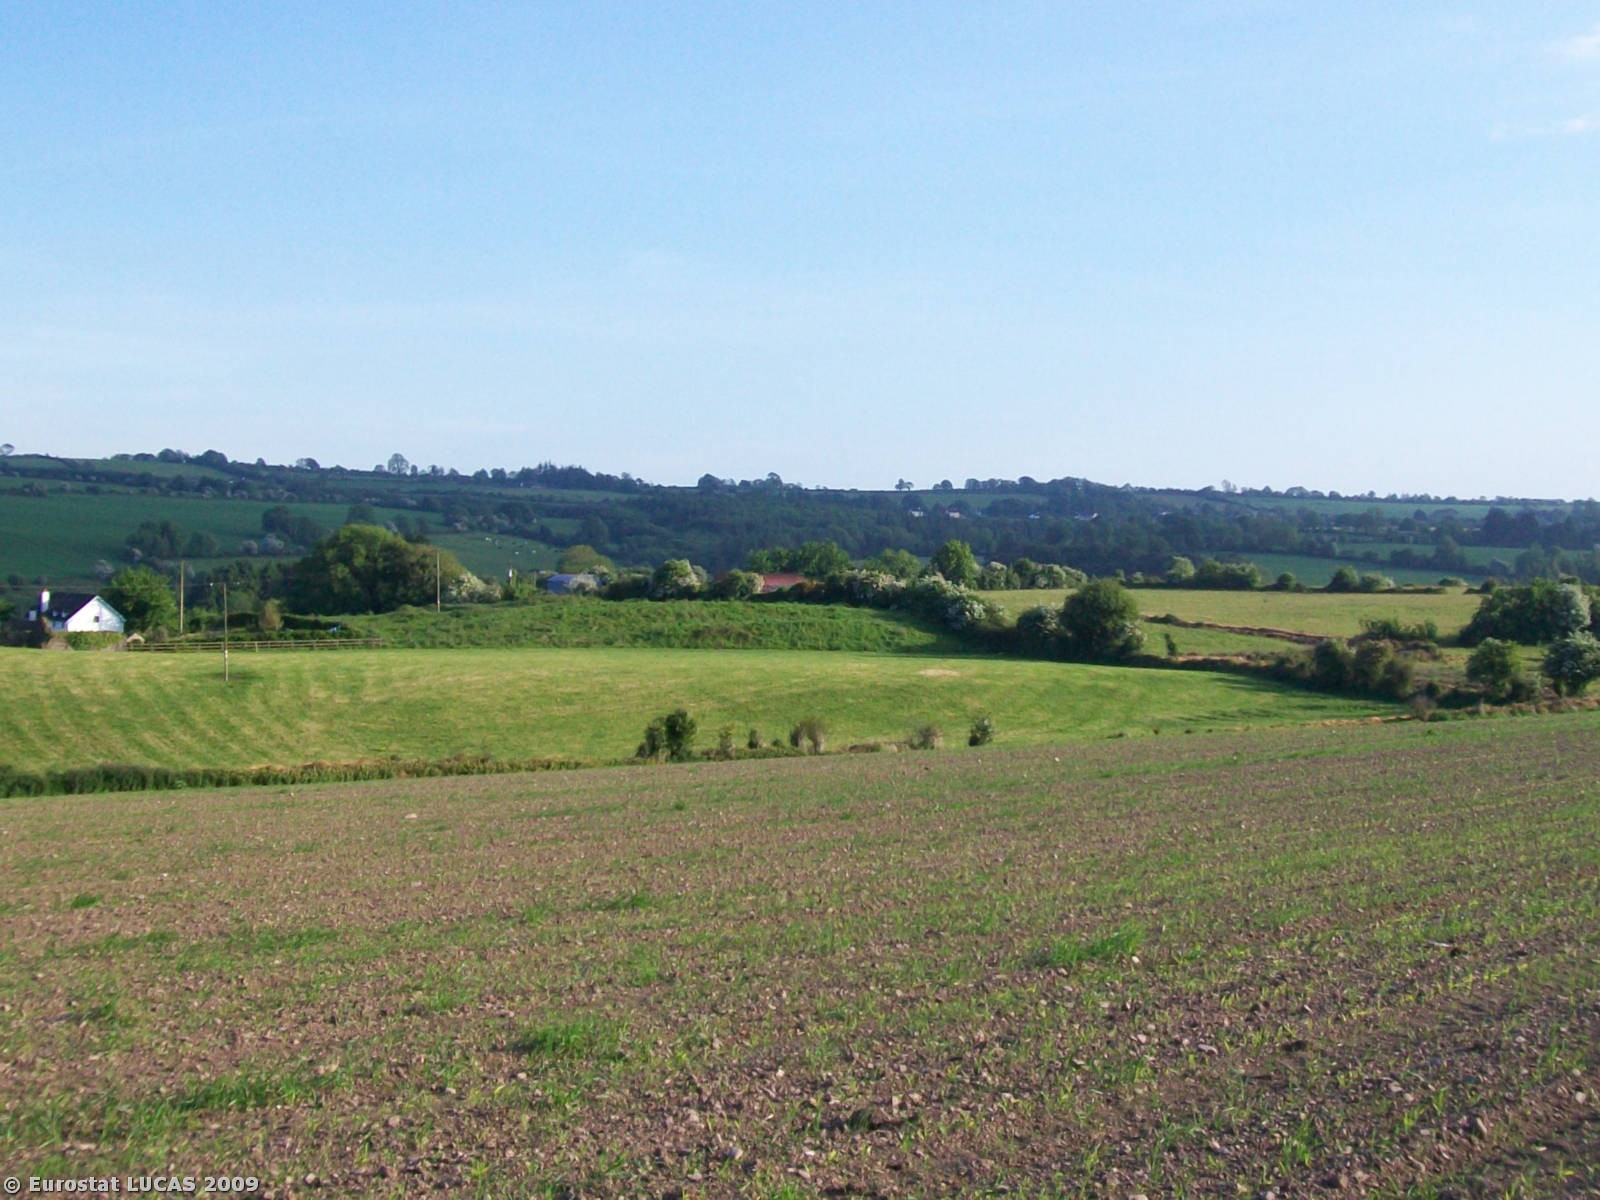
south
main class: Cropland
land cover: Common wheat
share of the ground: > 75 %
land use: Agriculture (excluding fallow land and kitchen gardens)
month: May
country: IE
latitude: 51.9012
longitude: -8.7333
